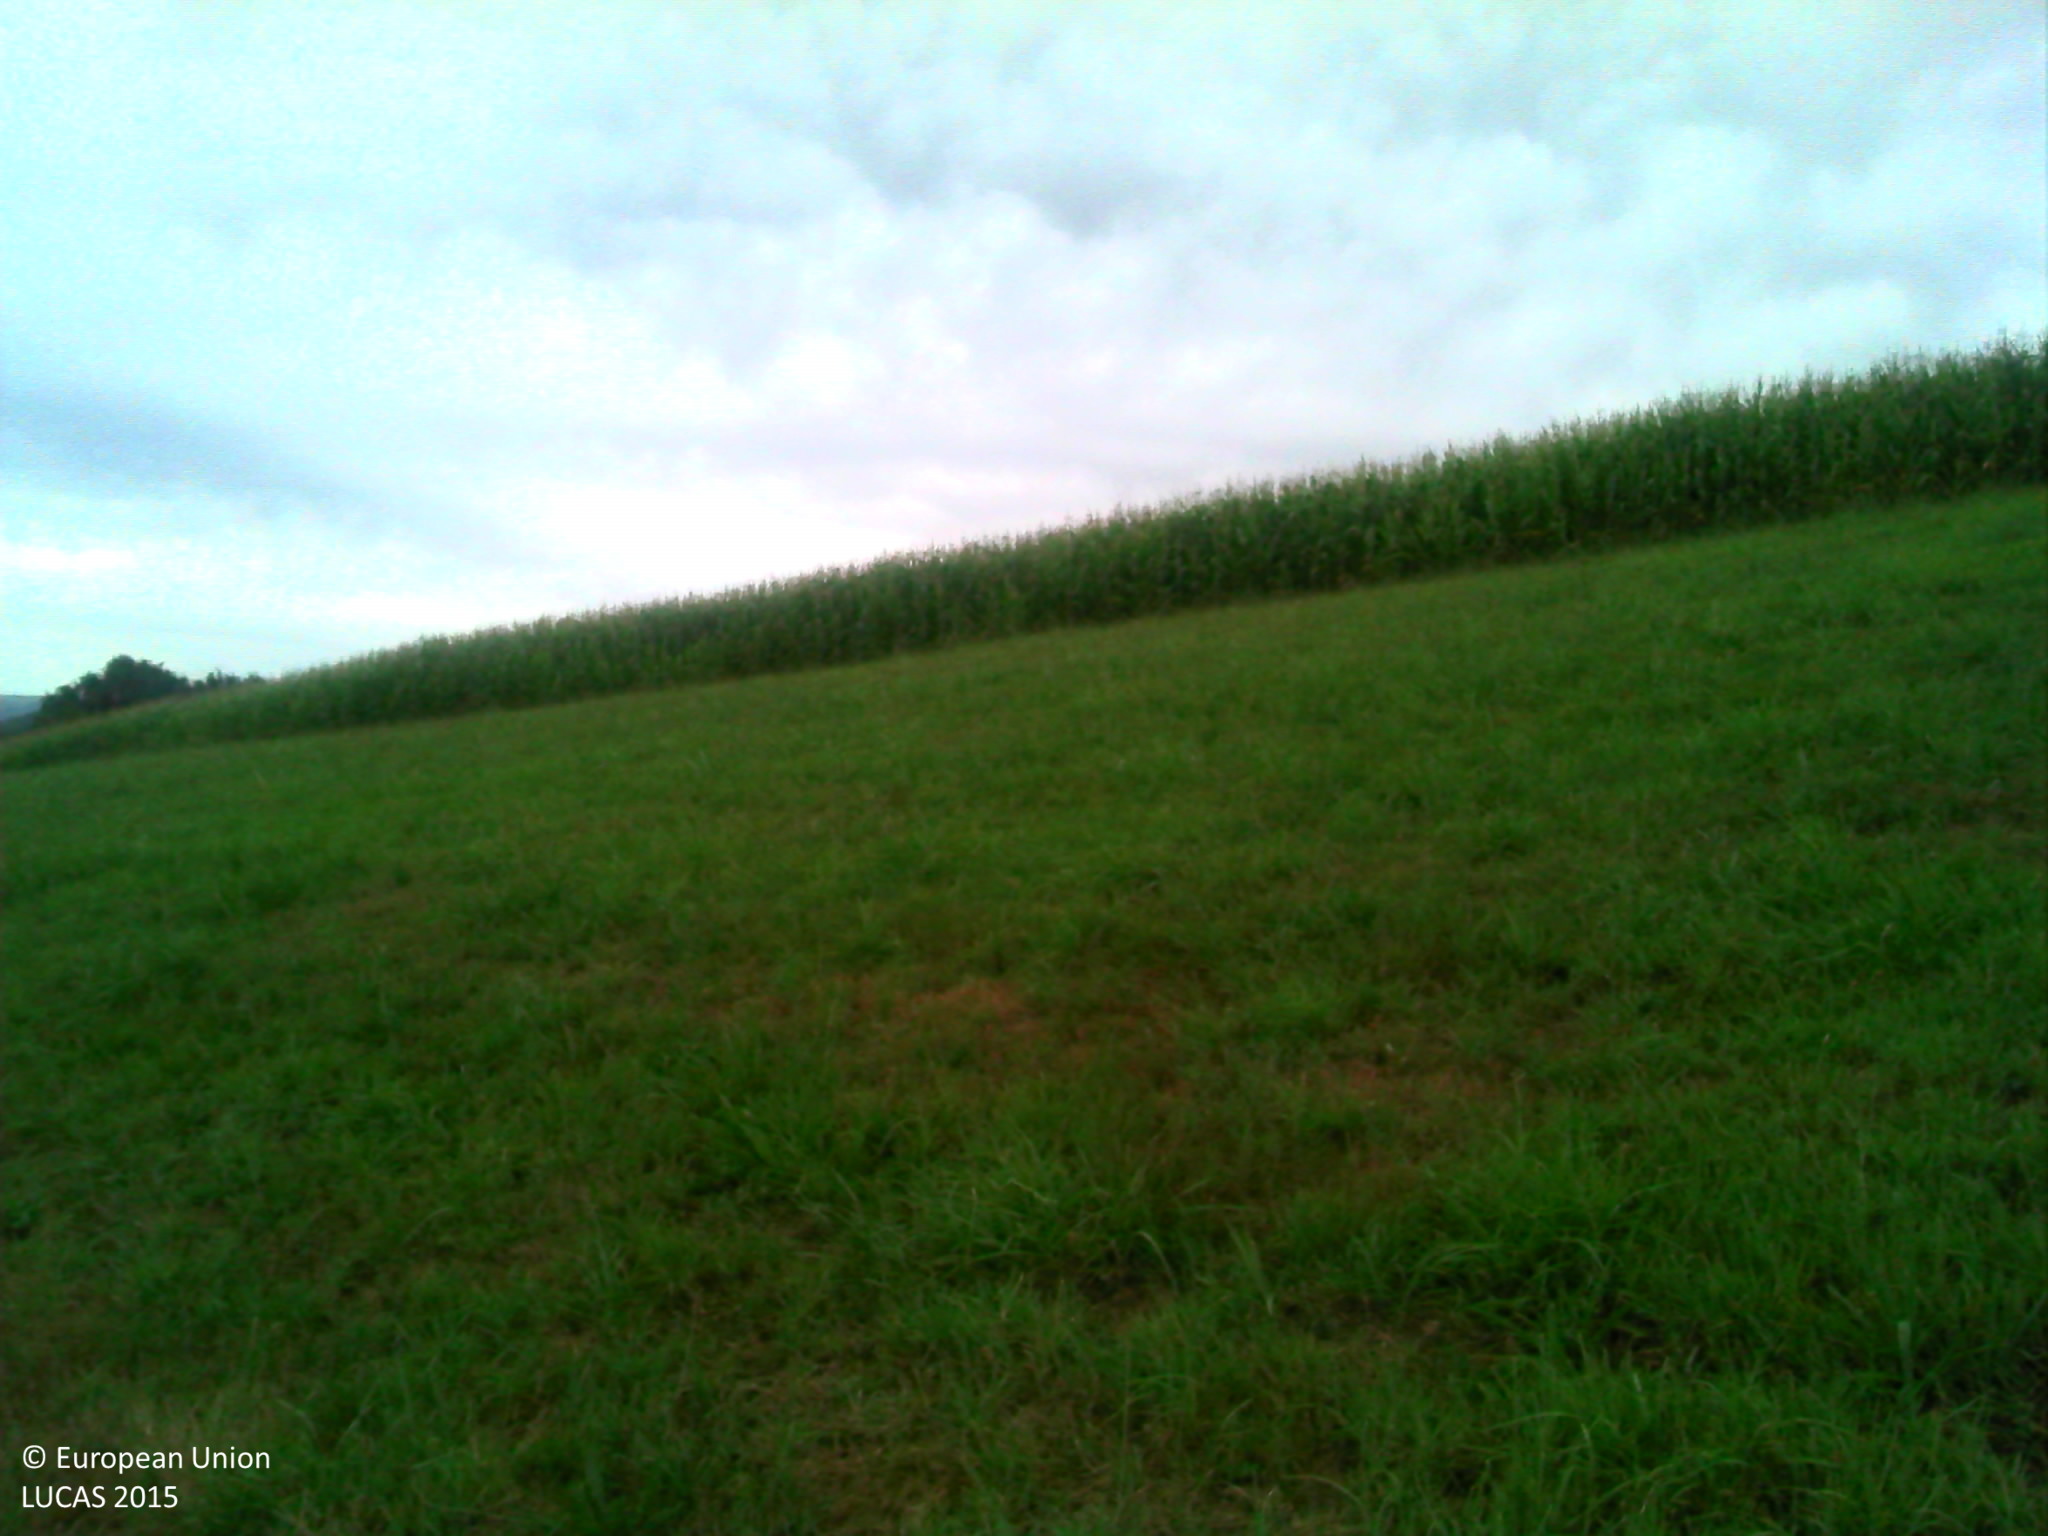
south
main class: Grassland
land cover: Grassland without tree/shrub cover
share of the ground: > 75 %
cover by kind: herbaceous plants 100 %
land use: Agriculture (excluding fallow land and kitchen gardens)
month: August
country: FR
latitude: 43.4512
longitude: -1.1988
